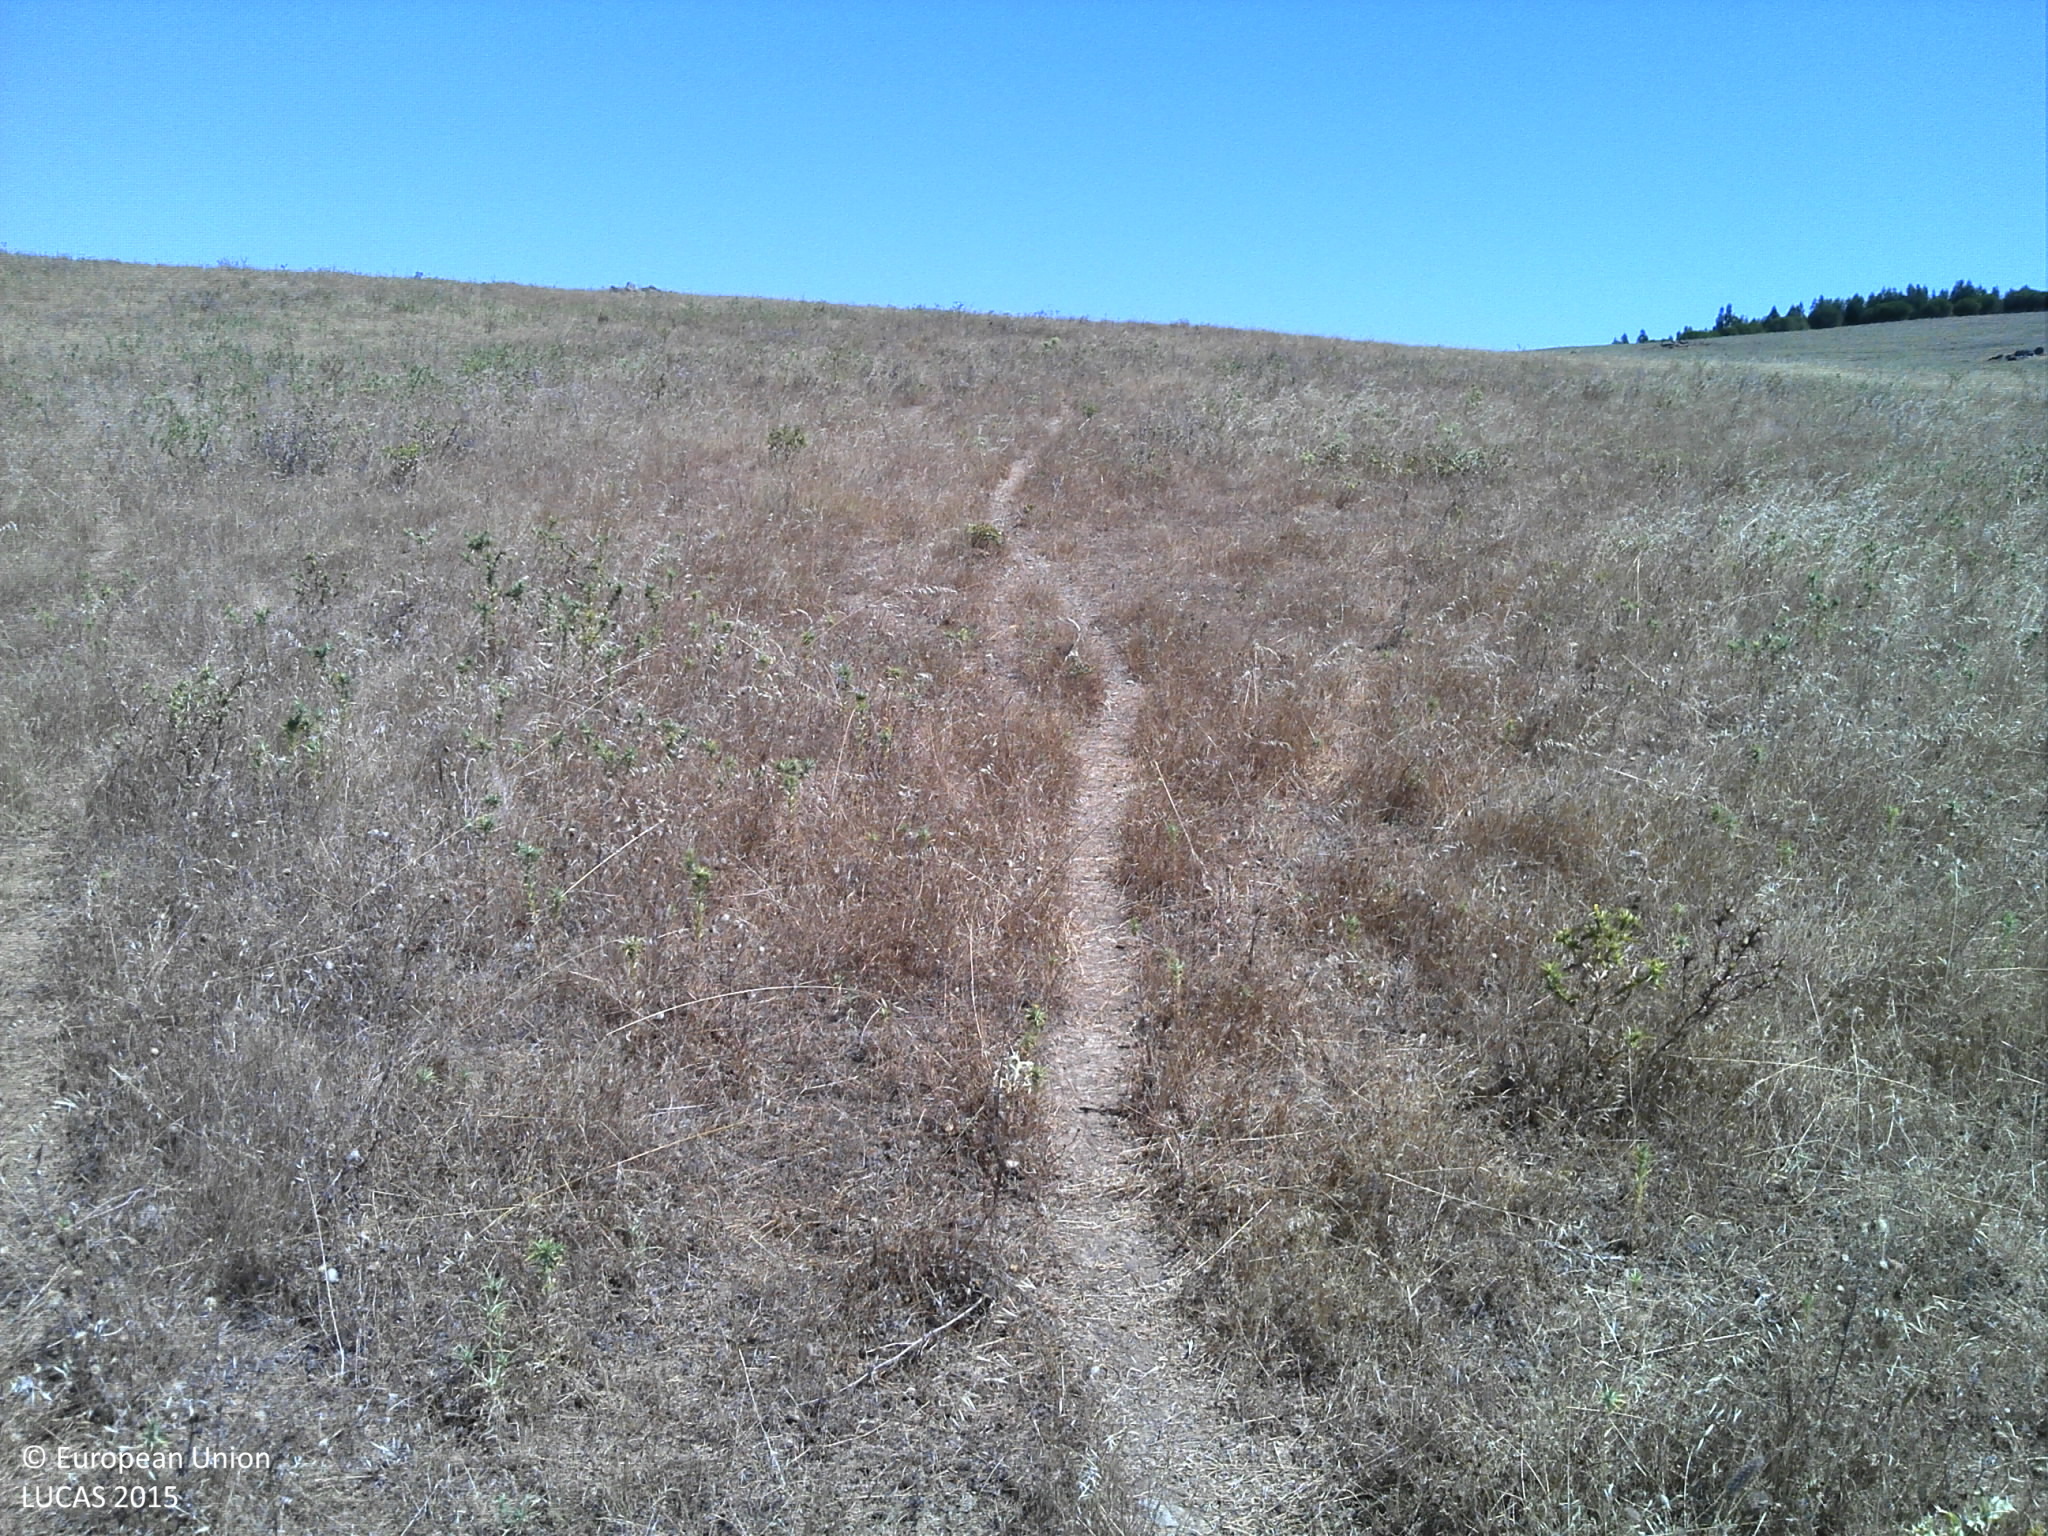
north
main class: Grassland
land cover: Grassland without tree/shrub cover
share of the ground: 50 - 75 %
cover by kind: herbaceous plants 70 %, unconsolidated bare surface 30 %
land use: Agriculture (excluding fallow land and kitchen gardens)
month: June
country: PT
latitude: 37.7883
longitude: -8.3045
